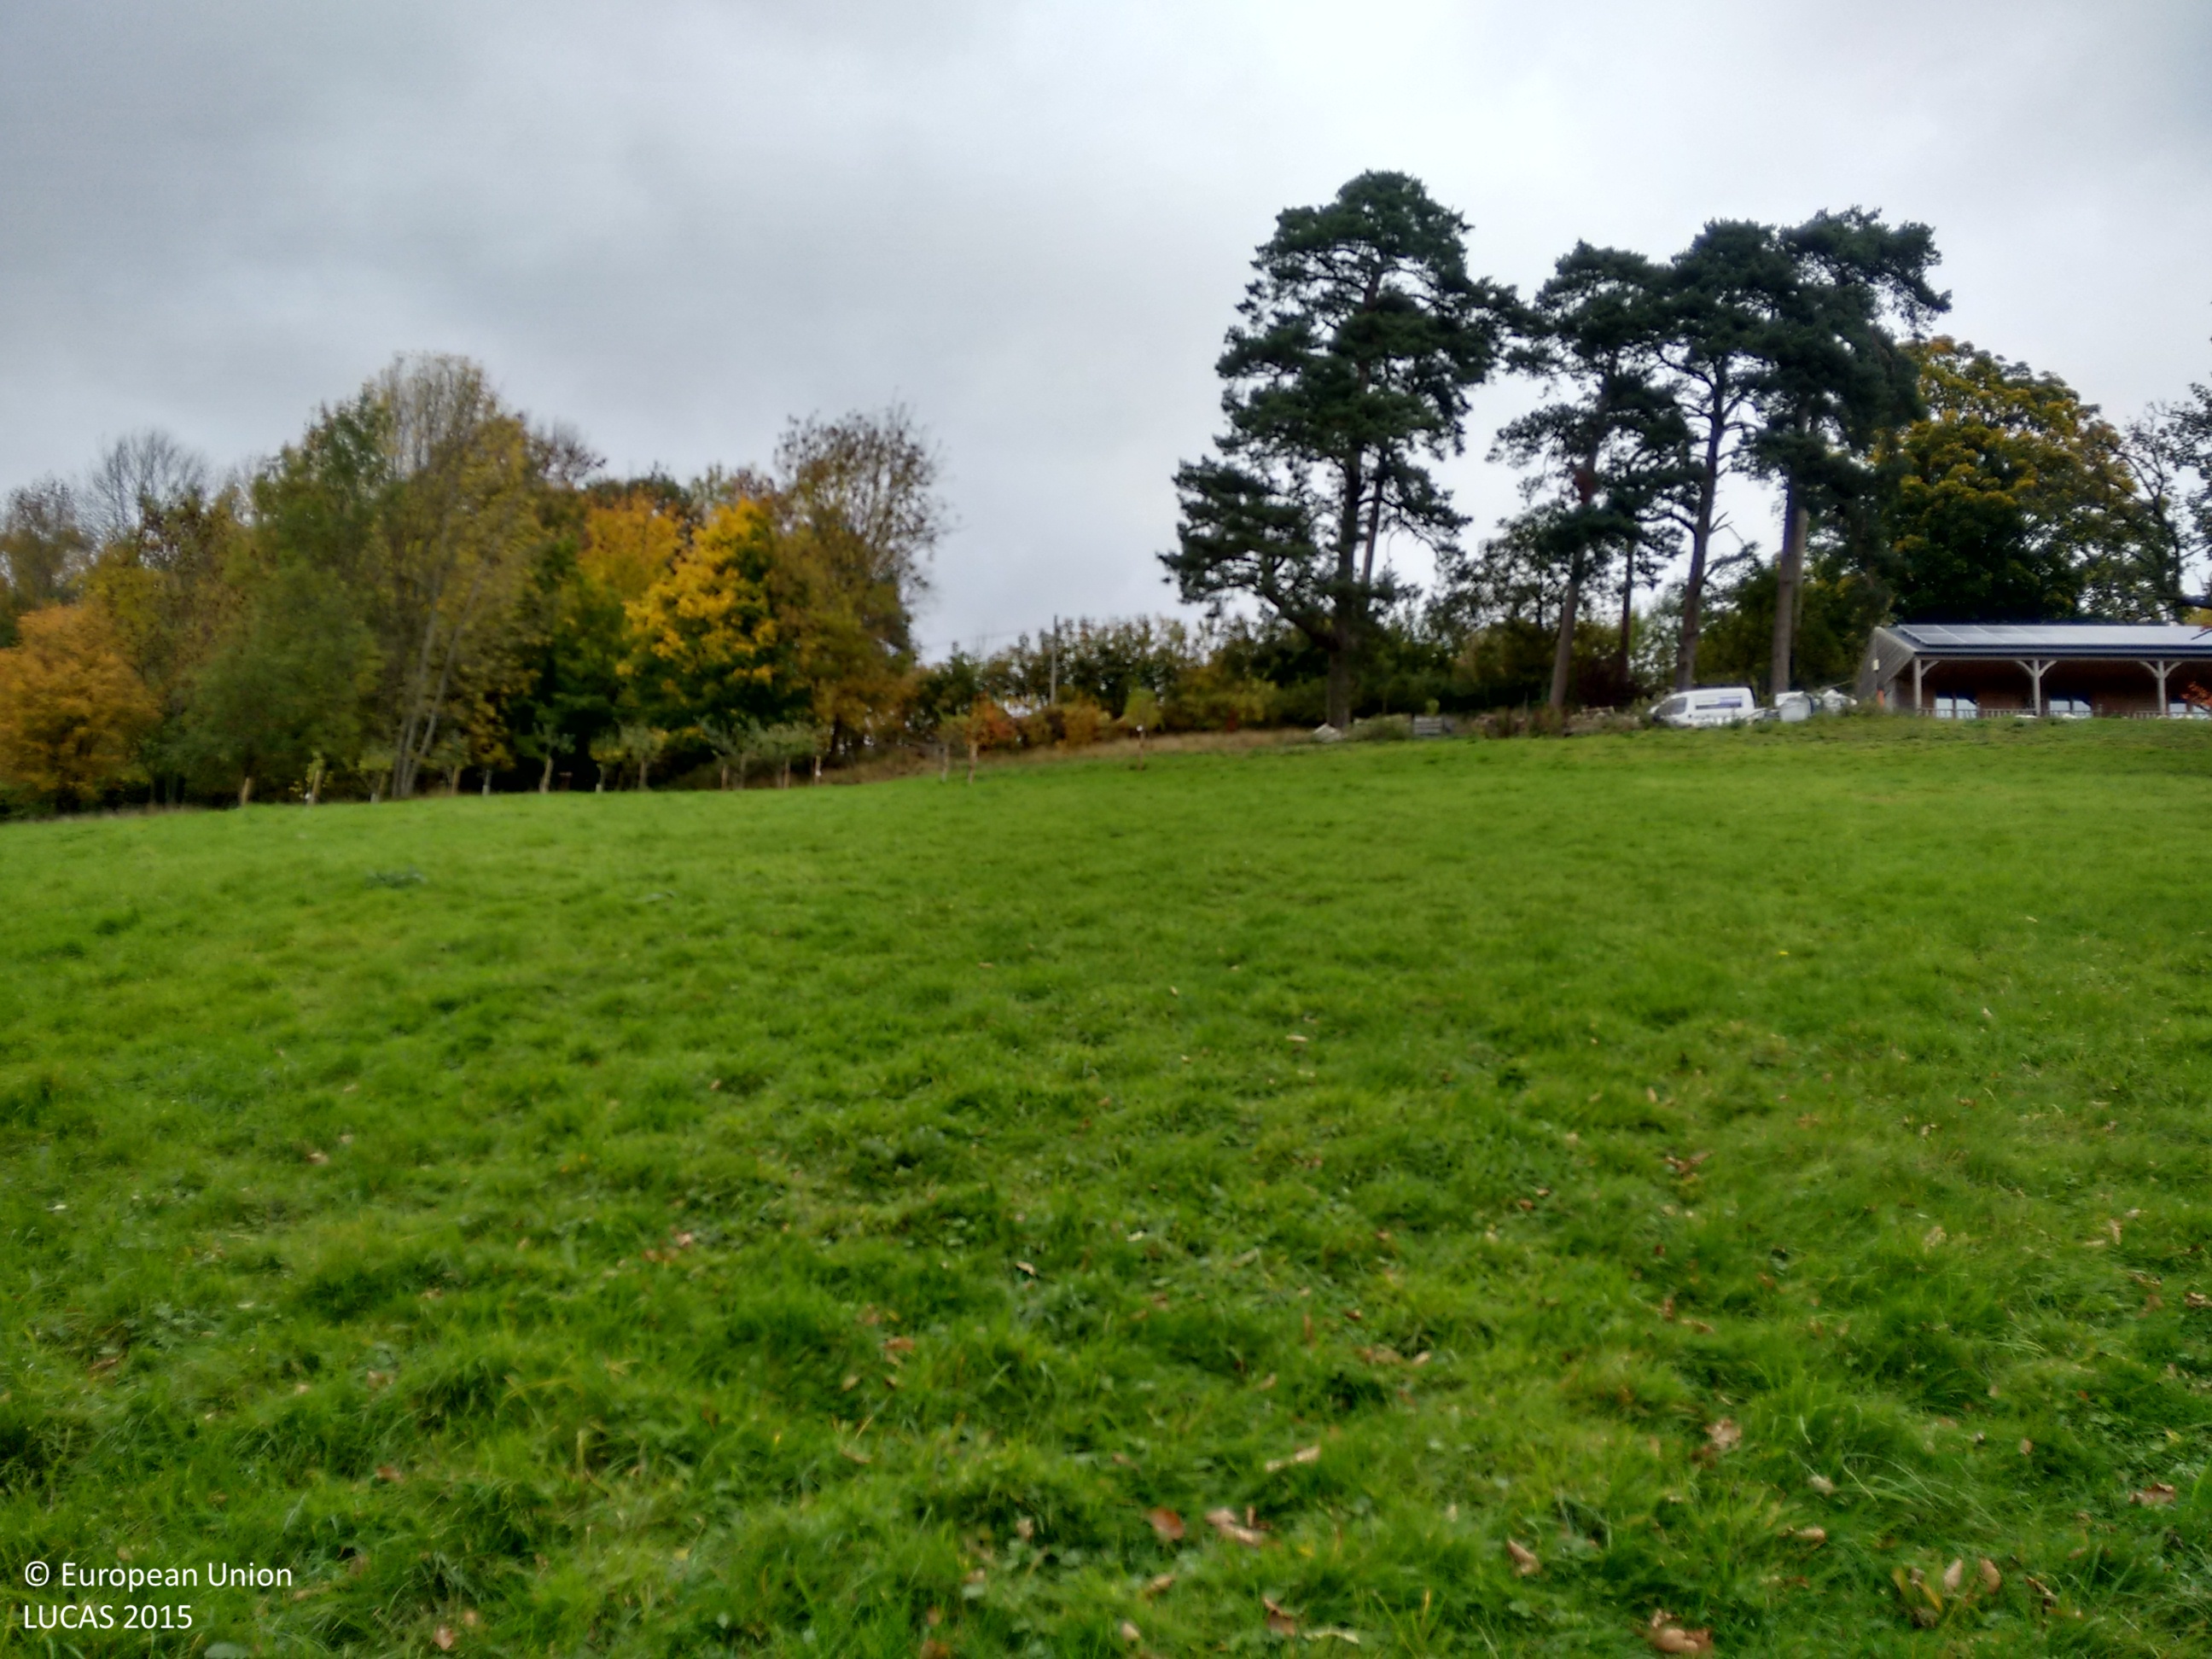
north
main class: Woodland
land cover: Other mixed woodland
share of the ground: > 75 %
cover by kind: broadleaved forest trees 40 %, coniferous forest trees 30 %, herbaceous plants 30 %
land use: Commerce
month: October
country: GB
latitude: 51.8665
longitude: -2.6011
